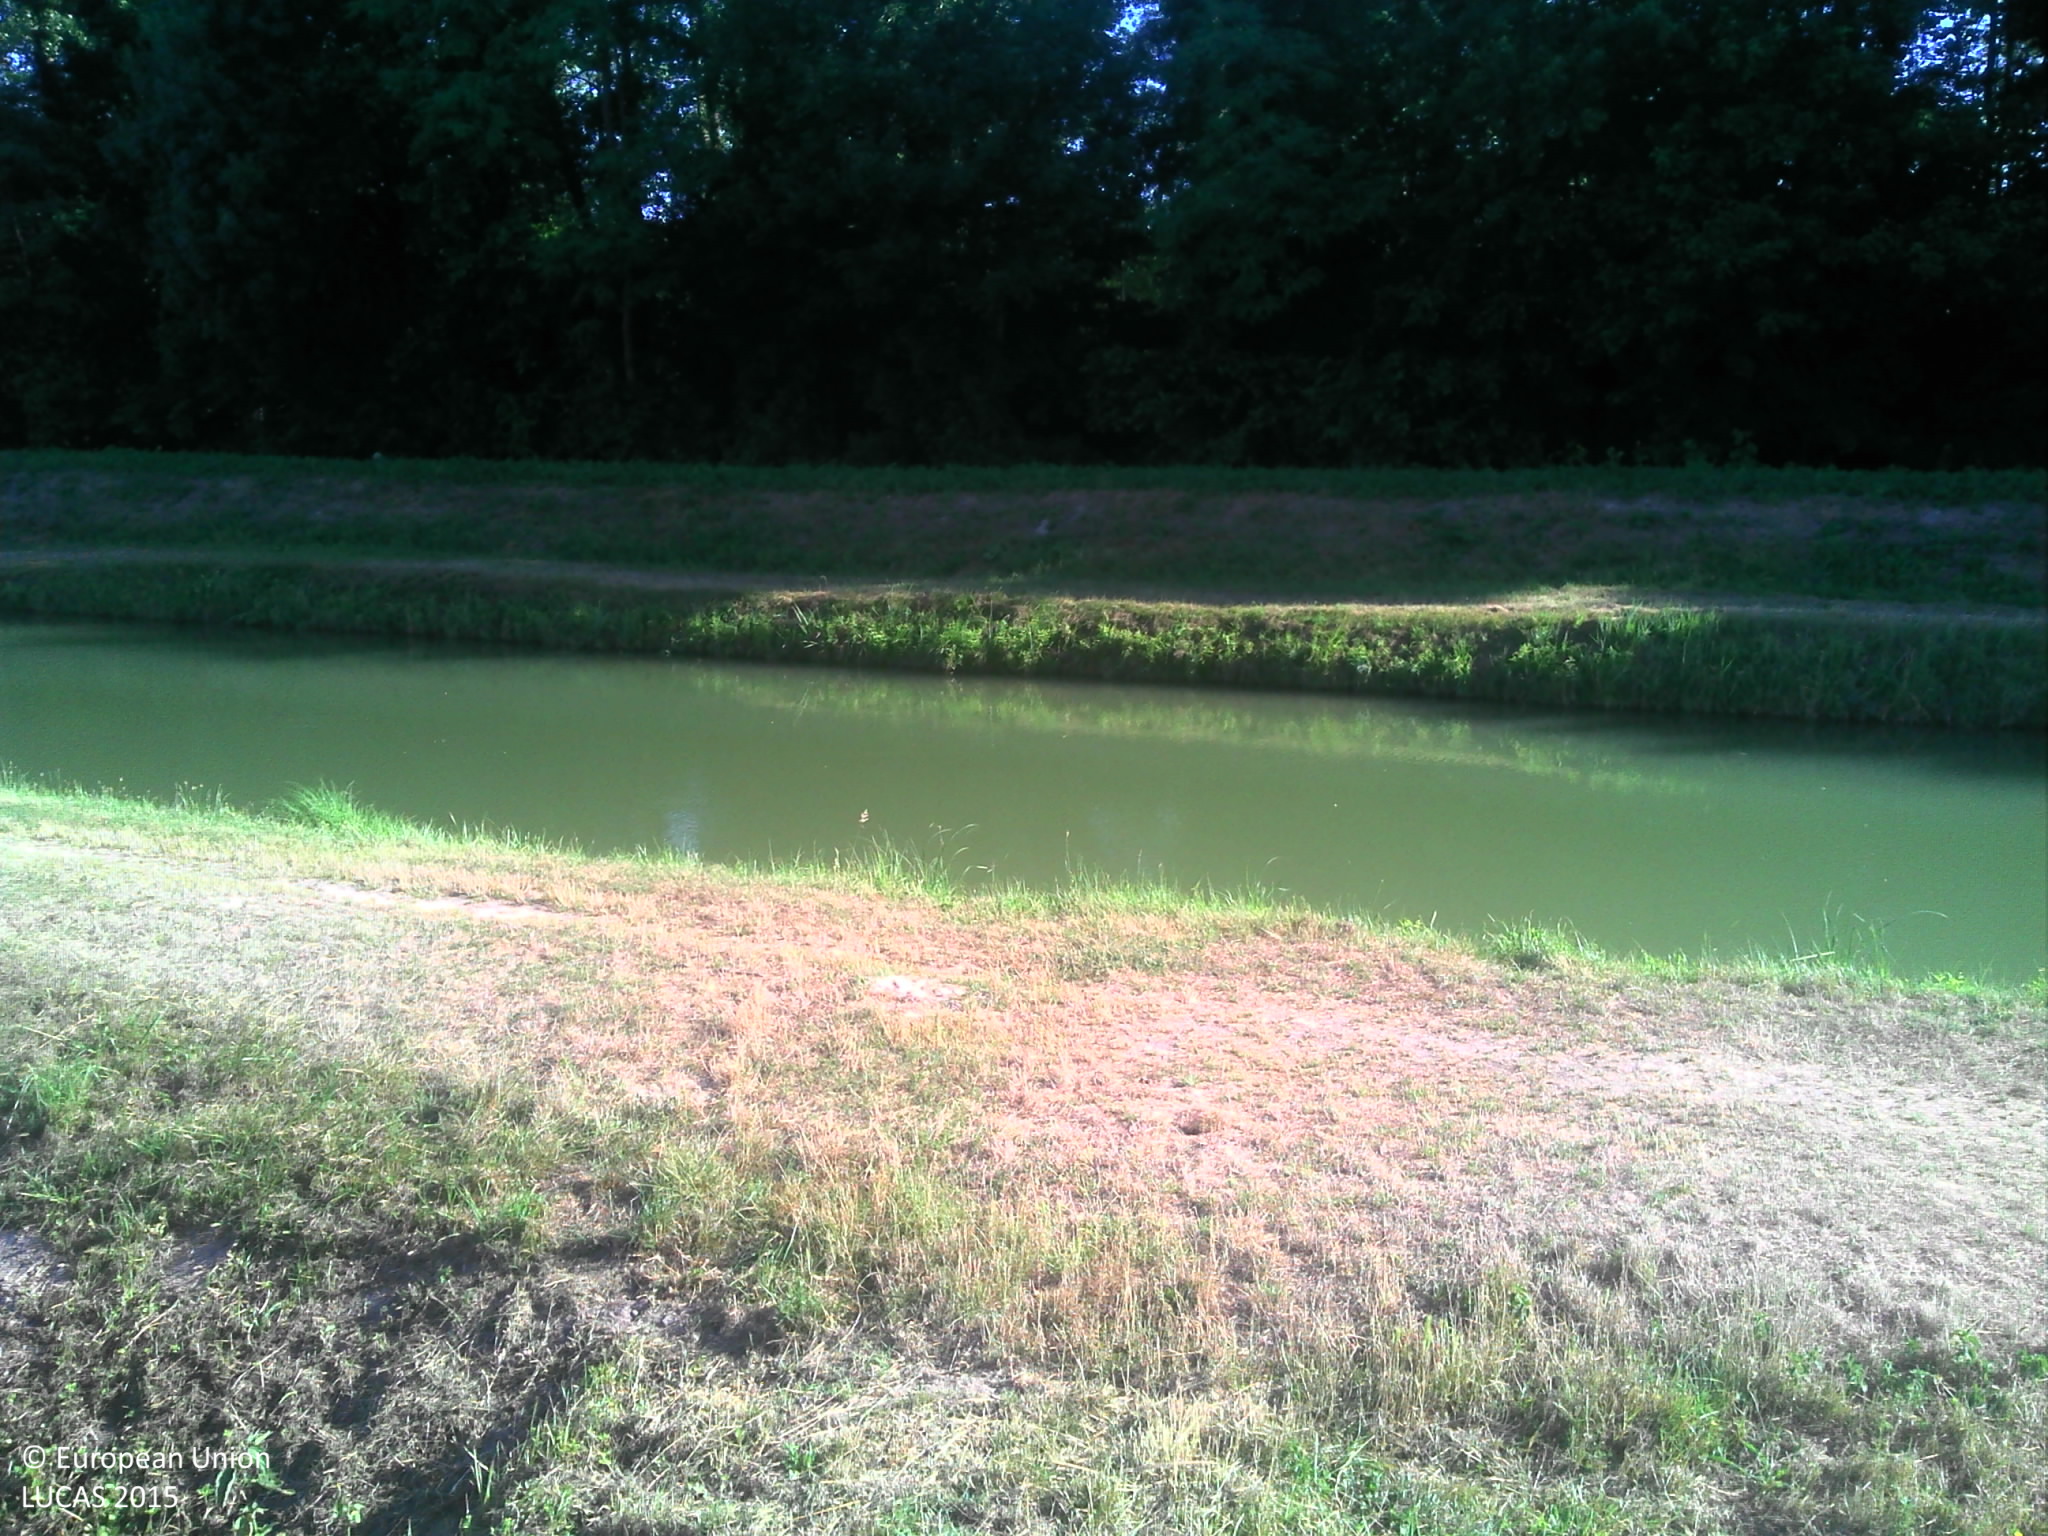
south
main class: Grassland
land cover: Grassland without tree/shrub cover
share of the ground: > 75 %
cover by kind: herbaceous plants 100 %
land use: Amenities, museums, leisure
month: June
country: FR
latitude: 47.2723
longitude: 1.4076
